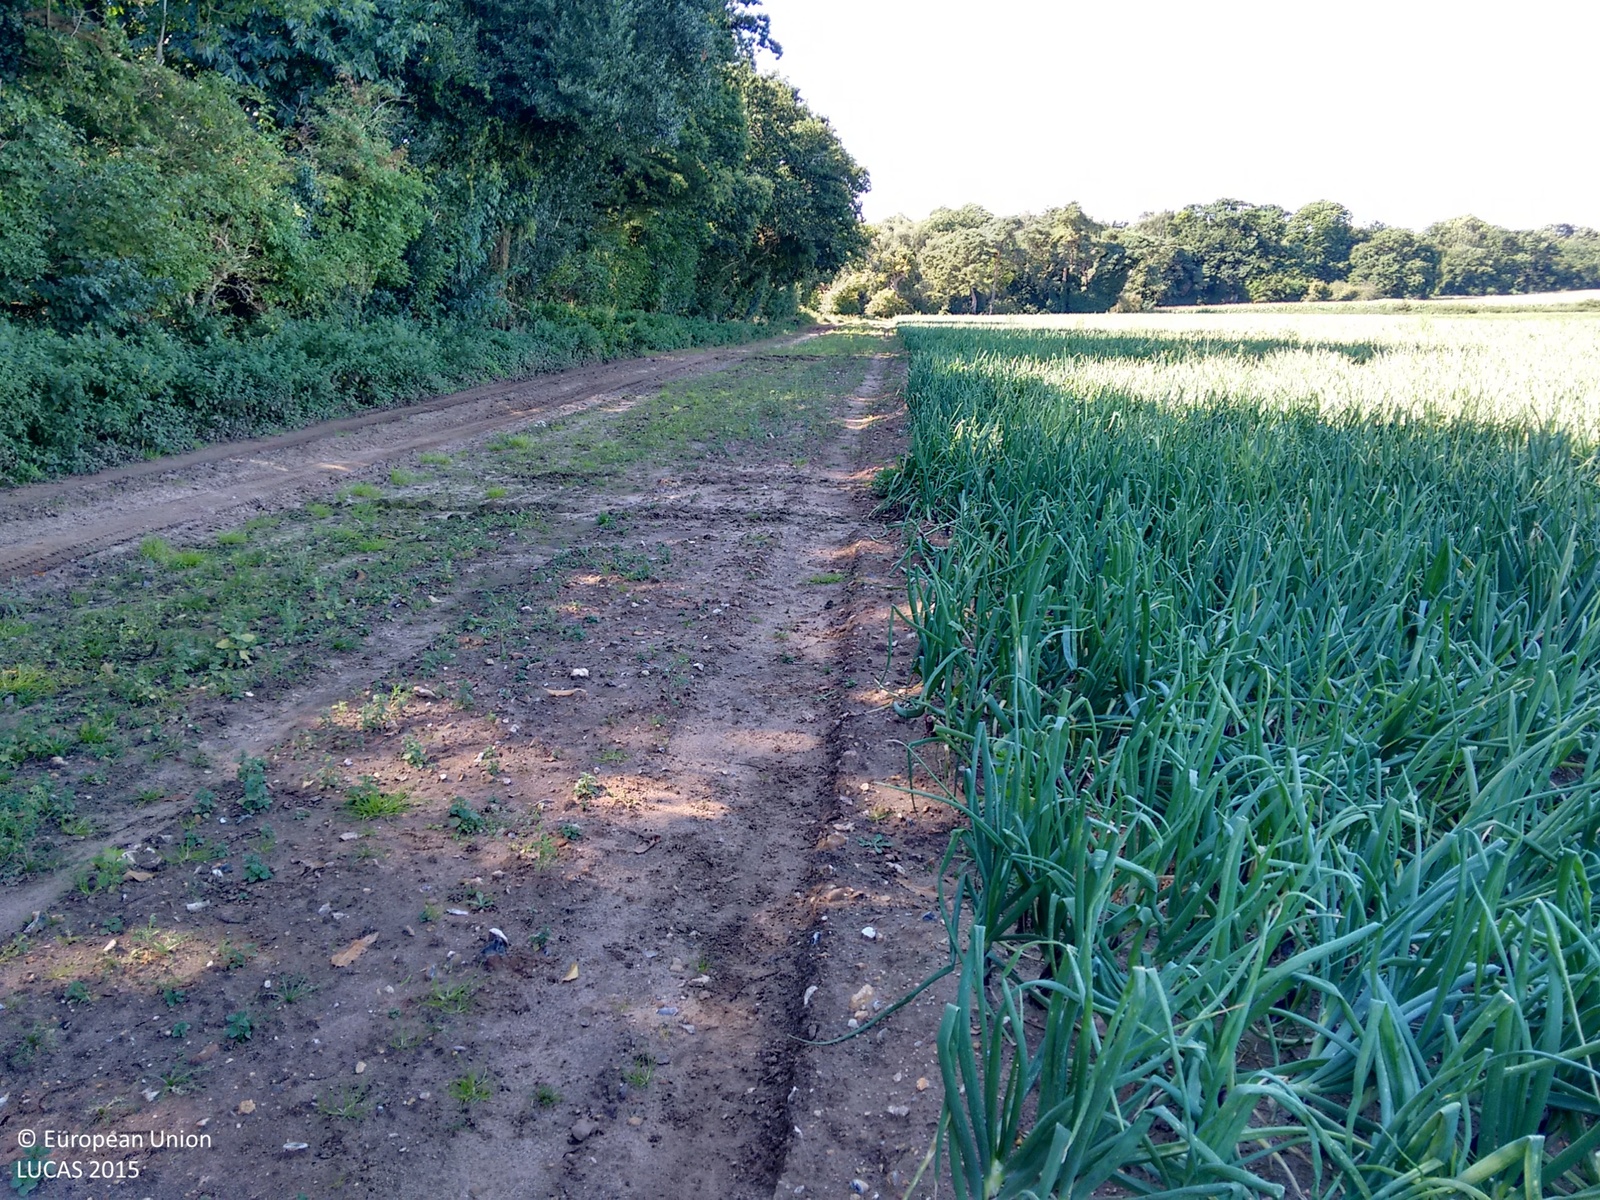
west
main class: Cropland
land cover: Other root crops
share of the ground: > 75 %
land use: Agriculture (excluding fallow land and kitchen gardens)
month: September
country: GB
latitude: 52.5280
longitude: 0.8218
